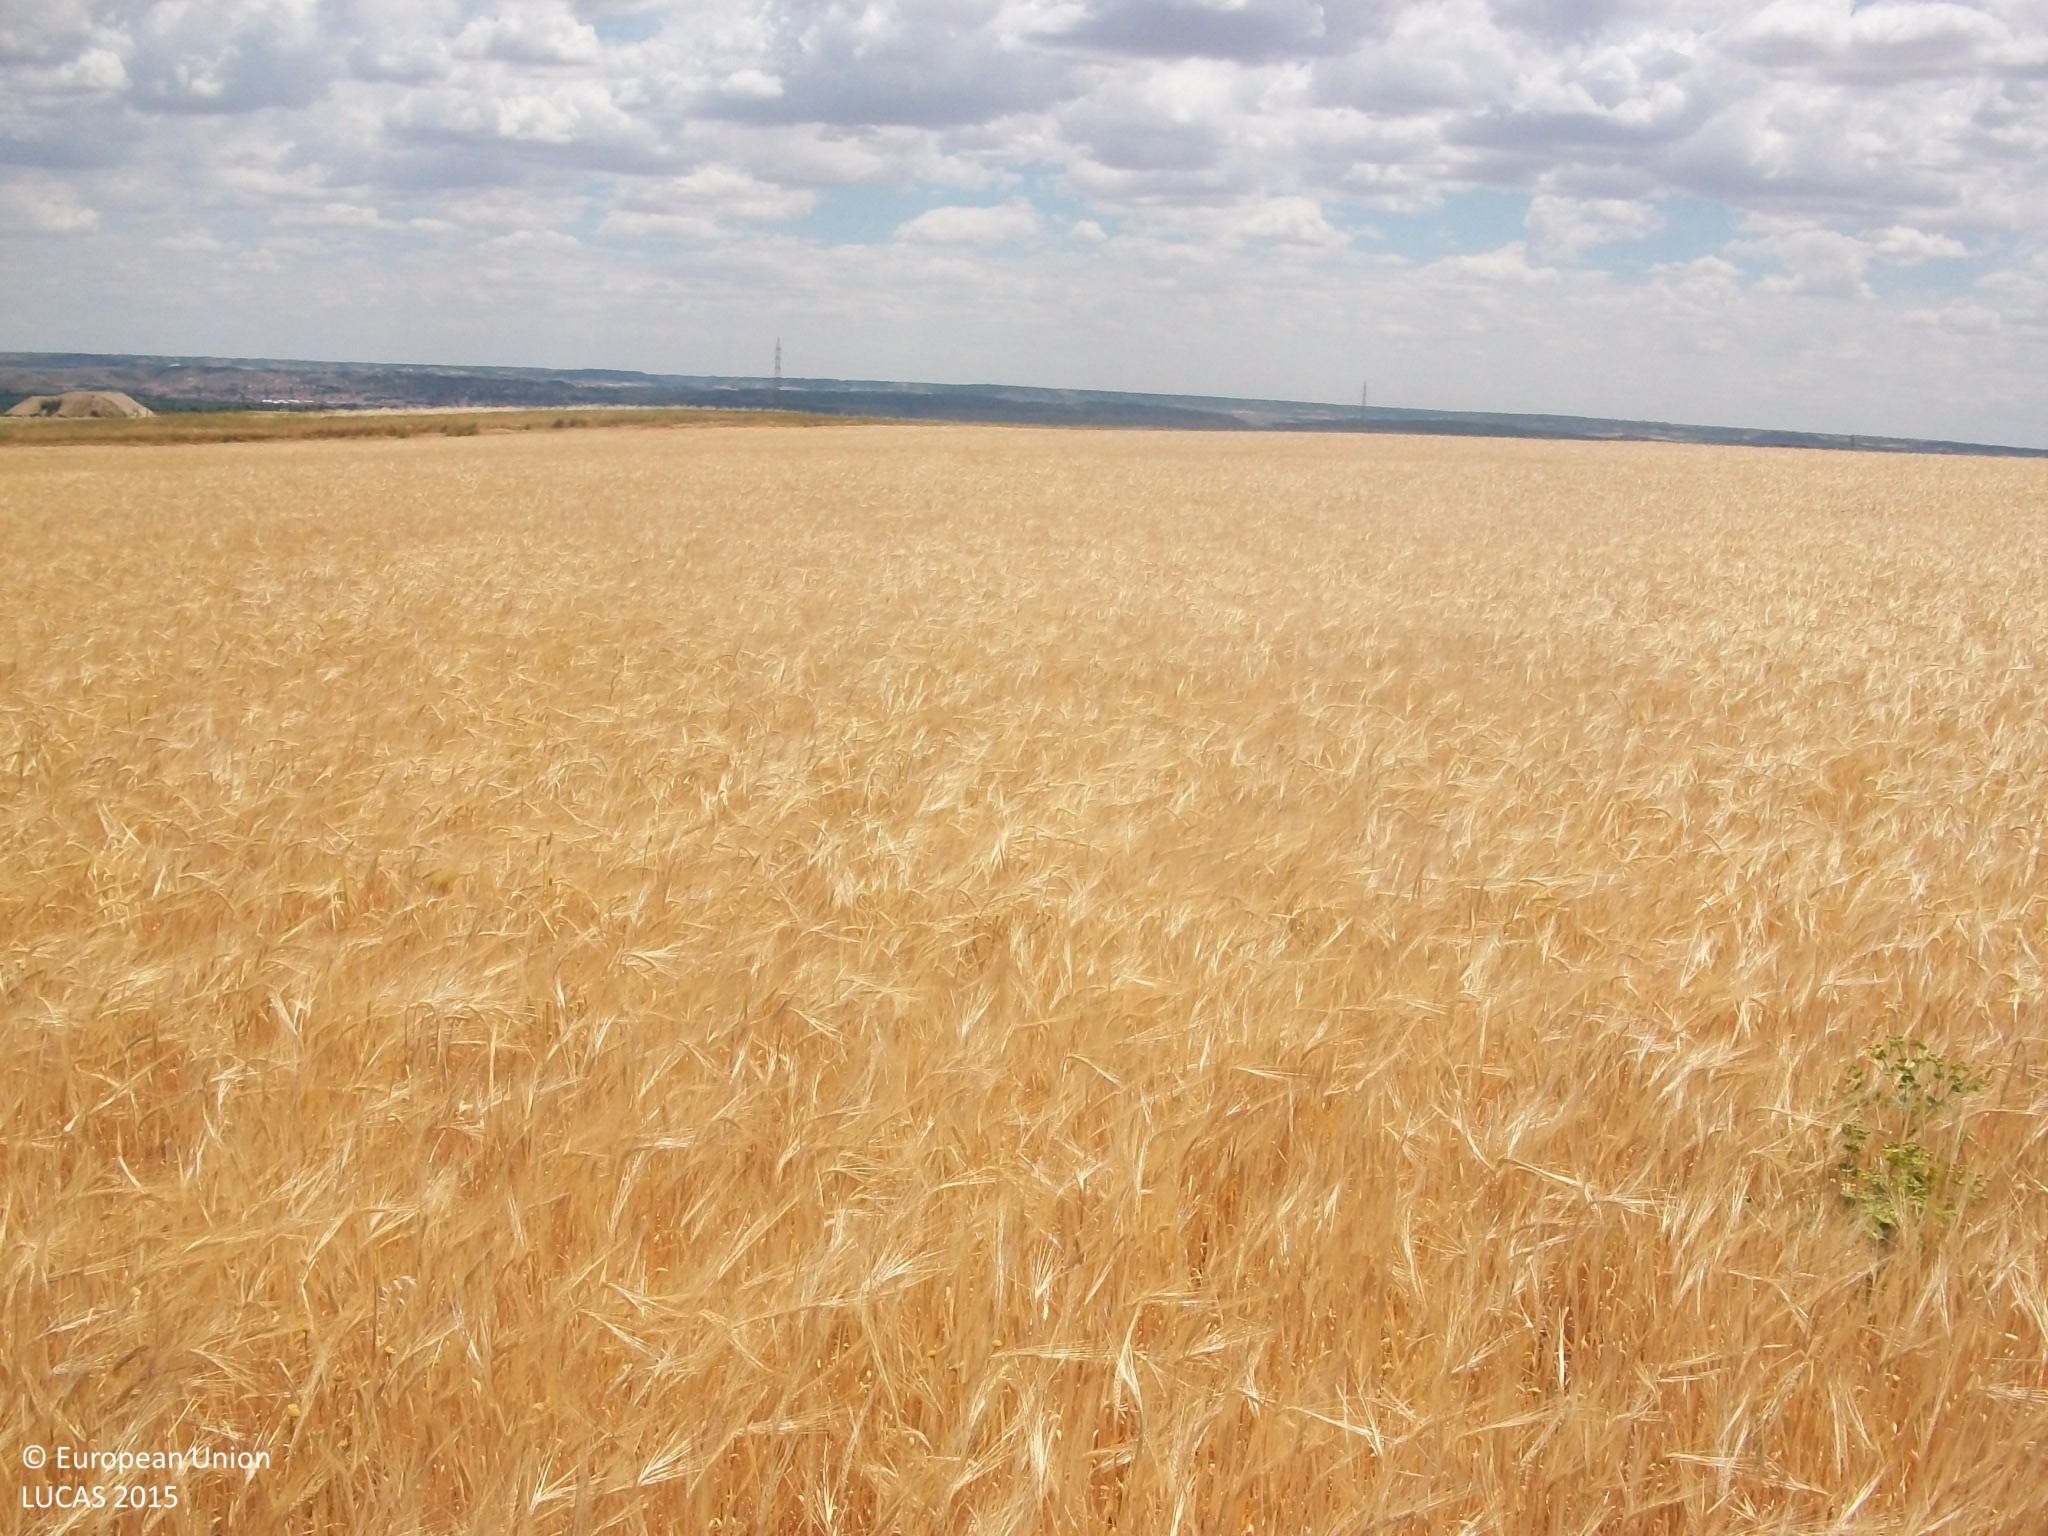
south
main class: Cropland
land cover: Barley
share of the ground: > 75 %
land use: Agriculture (excluding fallow land and kitchen gardens)
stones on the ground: 10 - 25 %
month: May
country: ES
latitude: 40.0750
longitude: -3.6701
